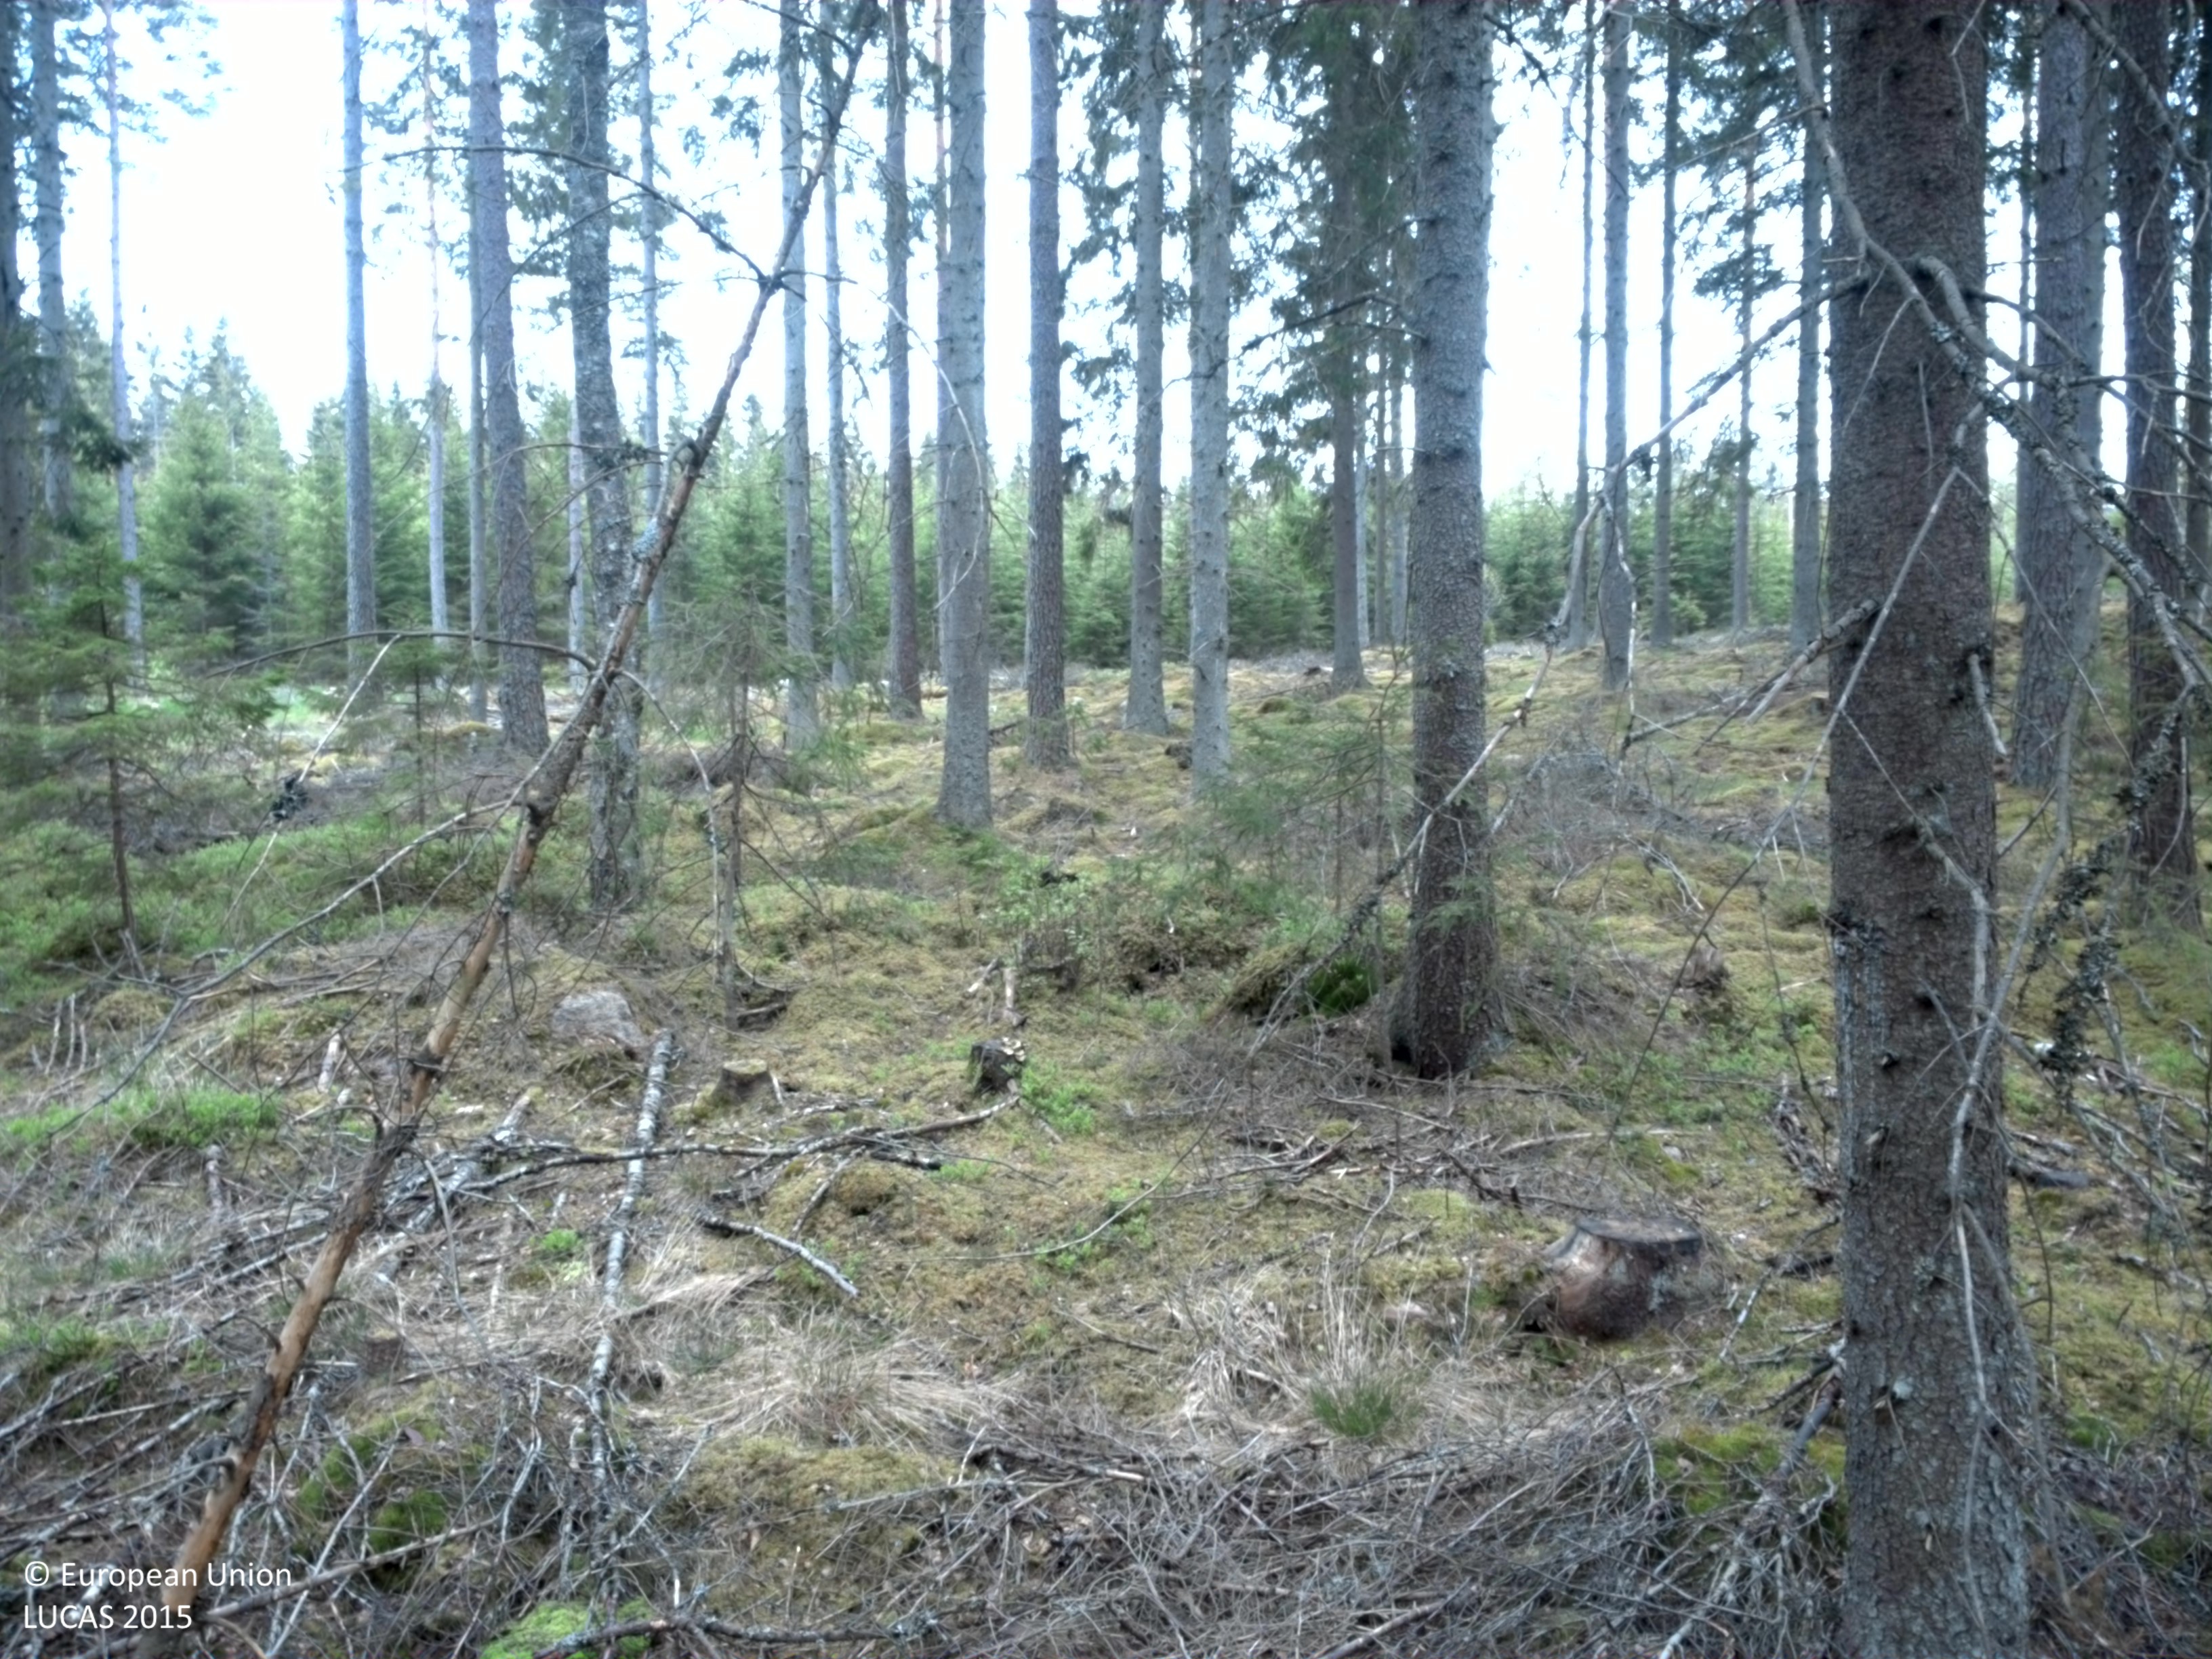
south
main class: Woodland
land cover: Spruce dominated coniferous woodland
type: boreal forest
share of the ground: > 75 %
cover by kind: coniferous forest trees 70 %, lichens and mosses 20 %, broadleaved forest trees 10 %
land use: Forestry
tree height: > 5 m
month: May
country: SE
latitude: 56.9470
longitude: 15.2088
